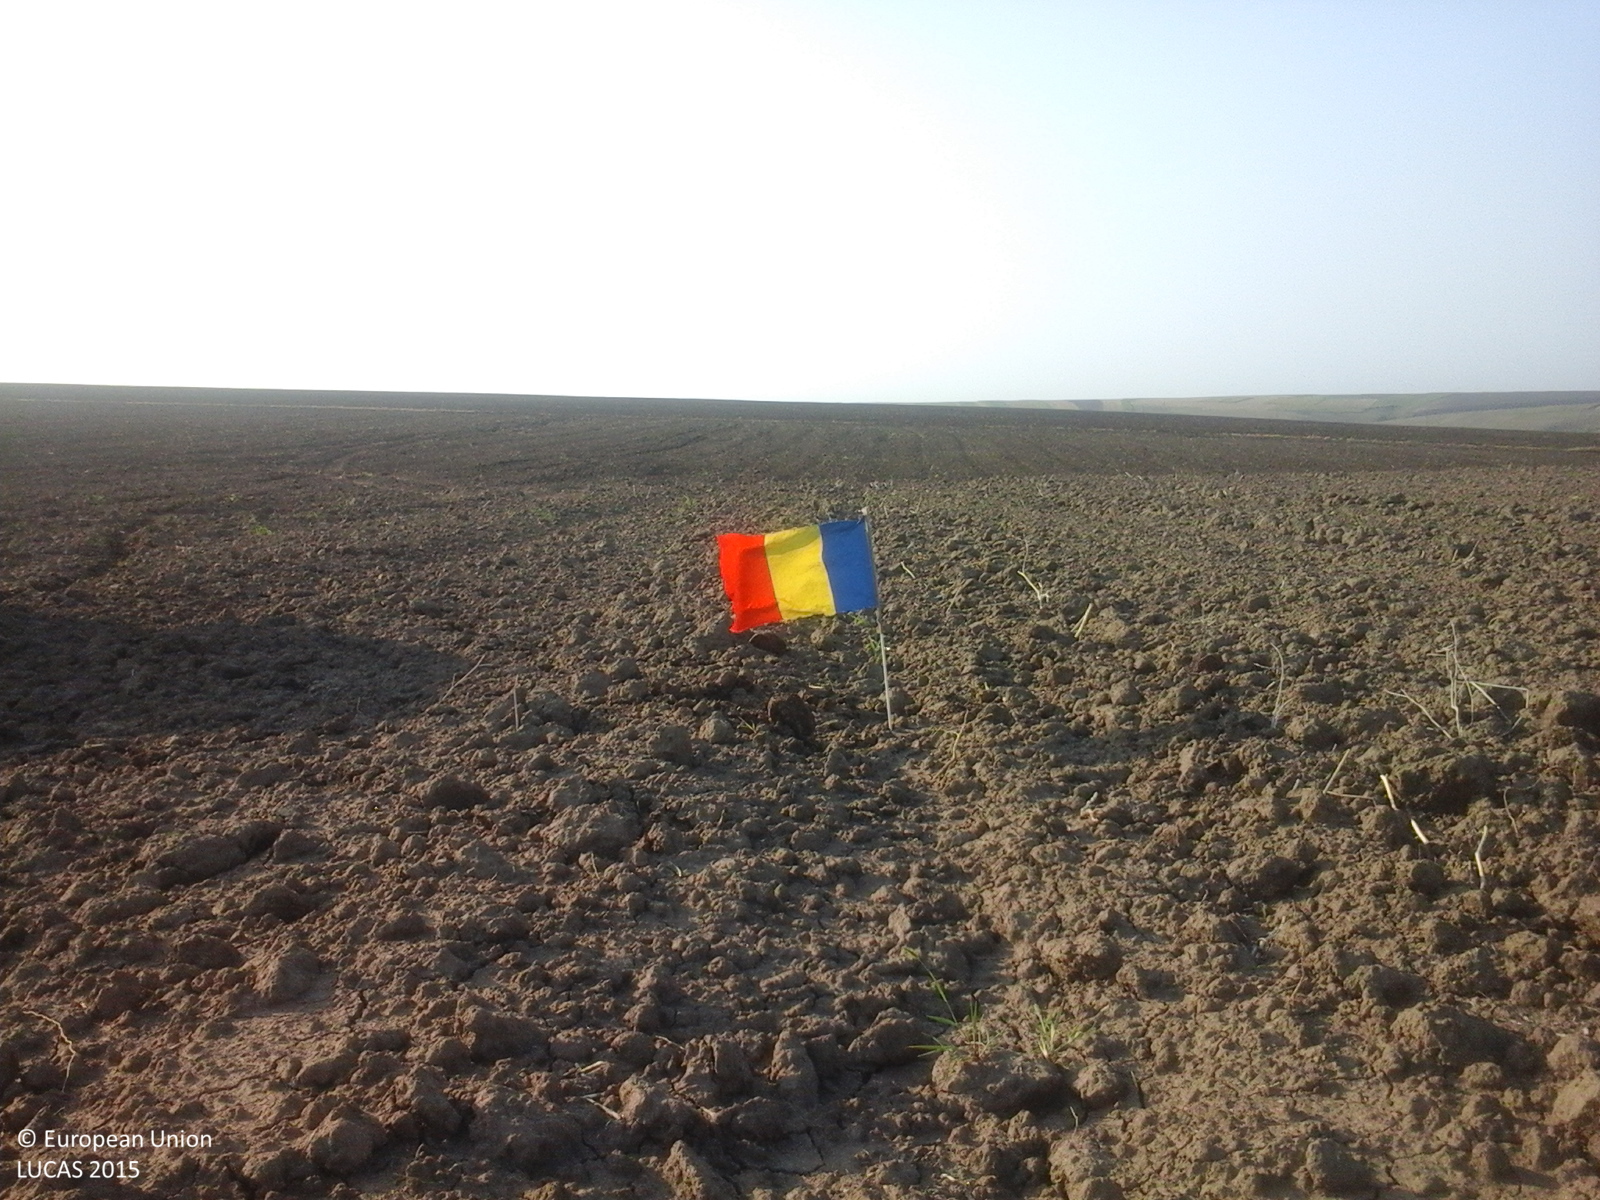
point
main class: Cropland
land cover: Rape and turnip rape
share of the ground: < 10 %
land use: Agriculture (excluding fallow land and kitchen gardens)
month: August
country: RO
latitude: 43.9796
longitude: 28.0940
